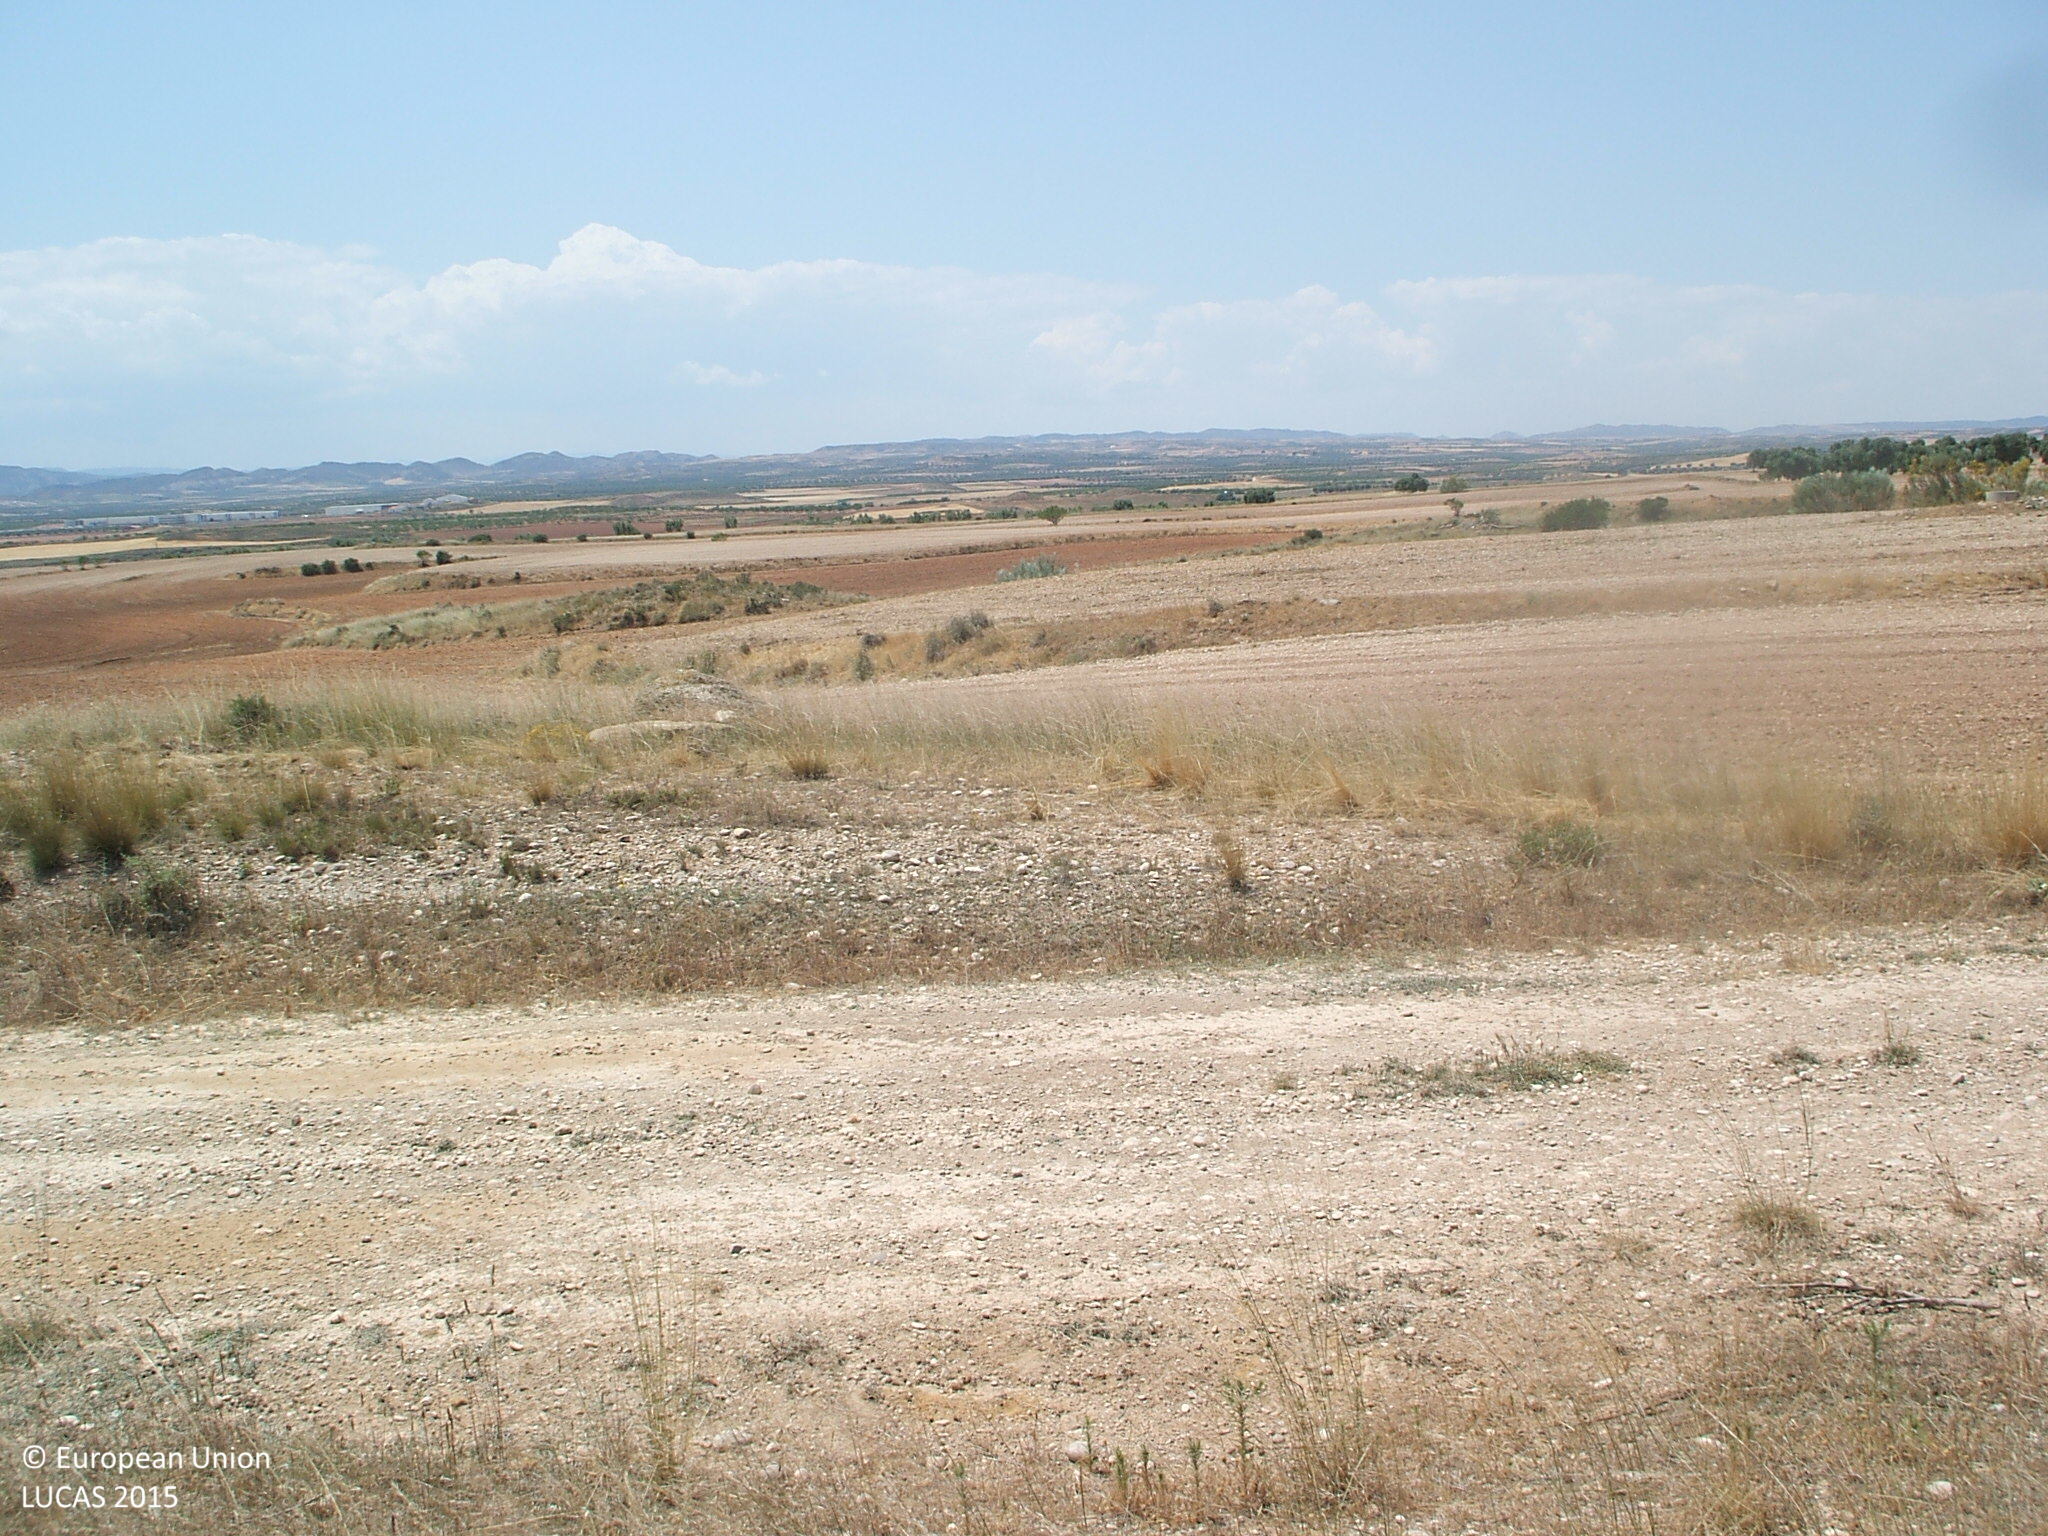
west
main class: Grassland
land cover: Grassland without tree/shrub cover
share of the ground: > 75 %
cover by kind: herbaceous plants 100 %
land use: Semi-natural and natural areas not in use
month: June
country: ES
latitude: 40.9915
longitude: -0.1983
